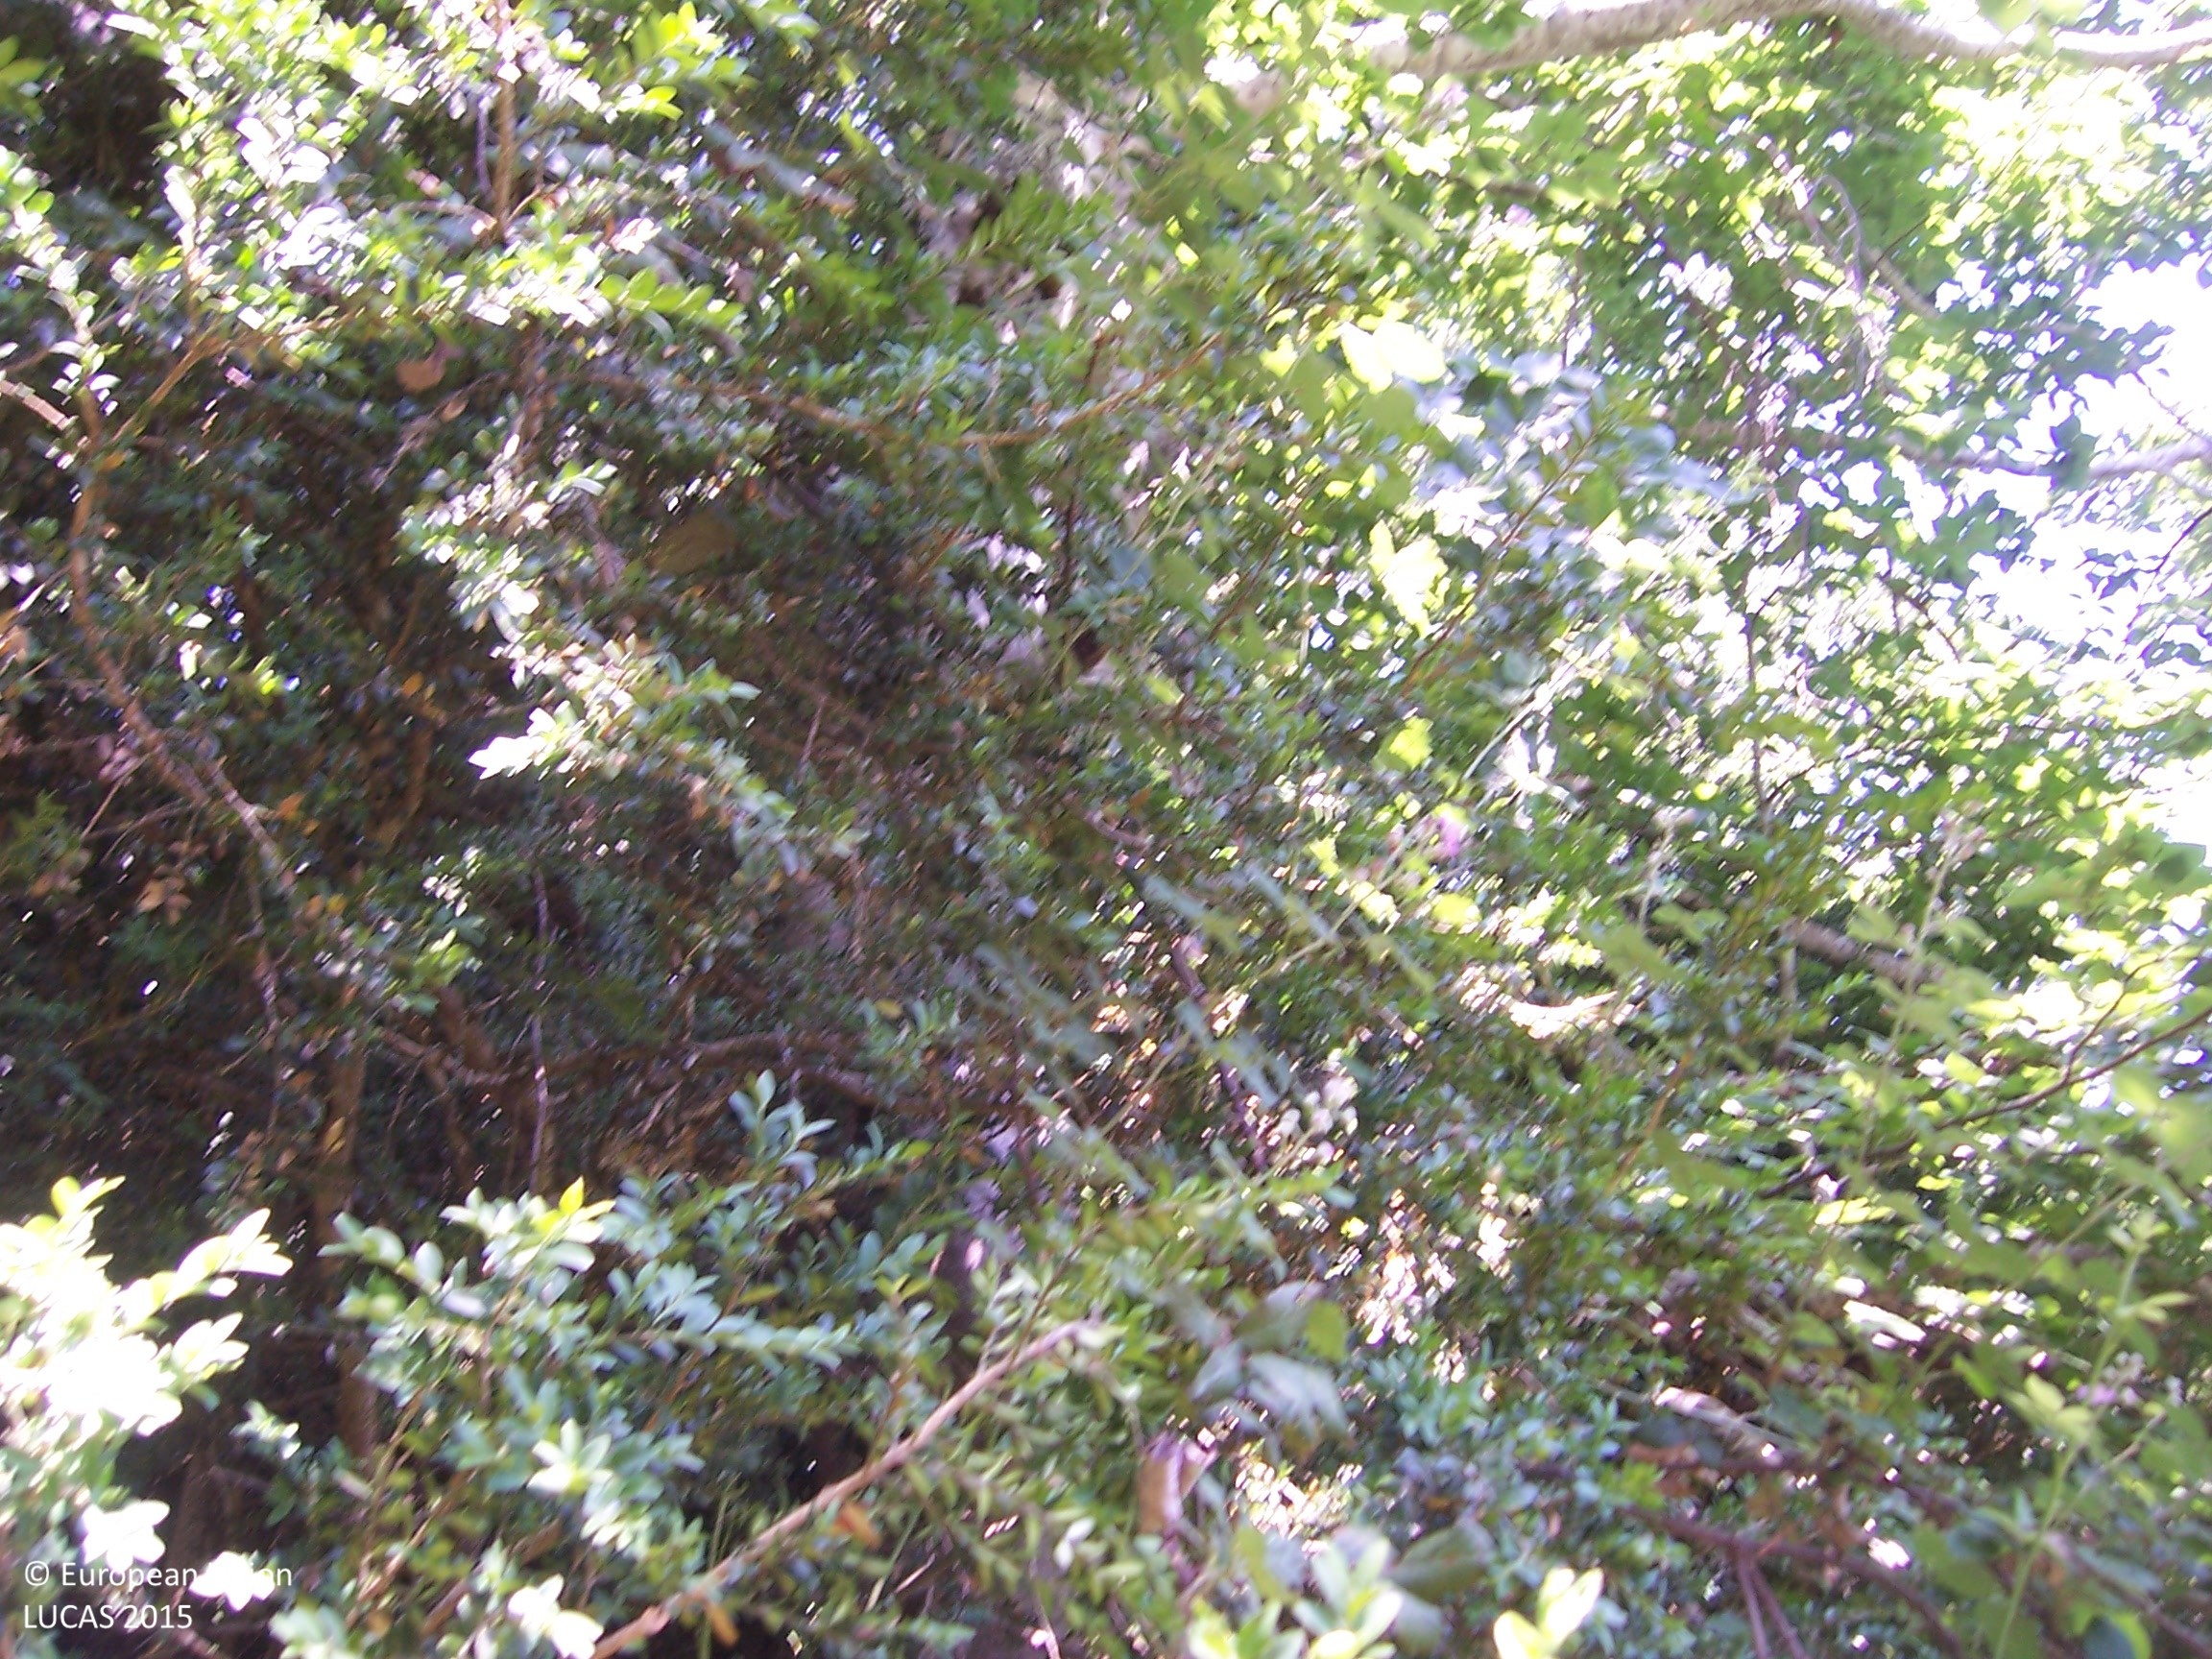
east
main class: Woodland
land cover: Broadleaved woodland
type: beech forest
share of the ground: > 75 %
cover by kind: broadleaved forest trees 75 %, coniferous forest trees 20 %, shrubs 5 %
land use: Forestry
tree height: > 5 m
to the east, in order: Broadleaved woodland; Shrubland without tree cover; Pine dominated coniferous woodland; Shrubland without tree cover
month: July
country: ES
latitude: 42.8620
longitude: -1.2592
